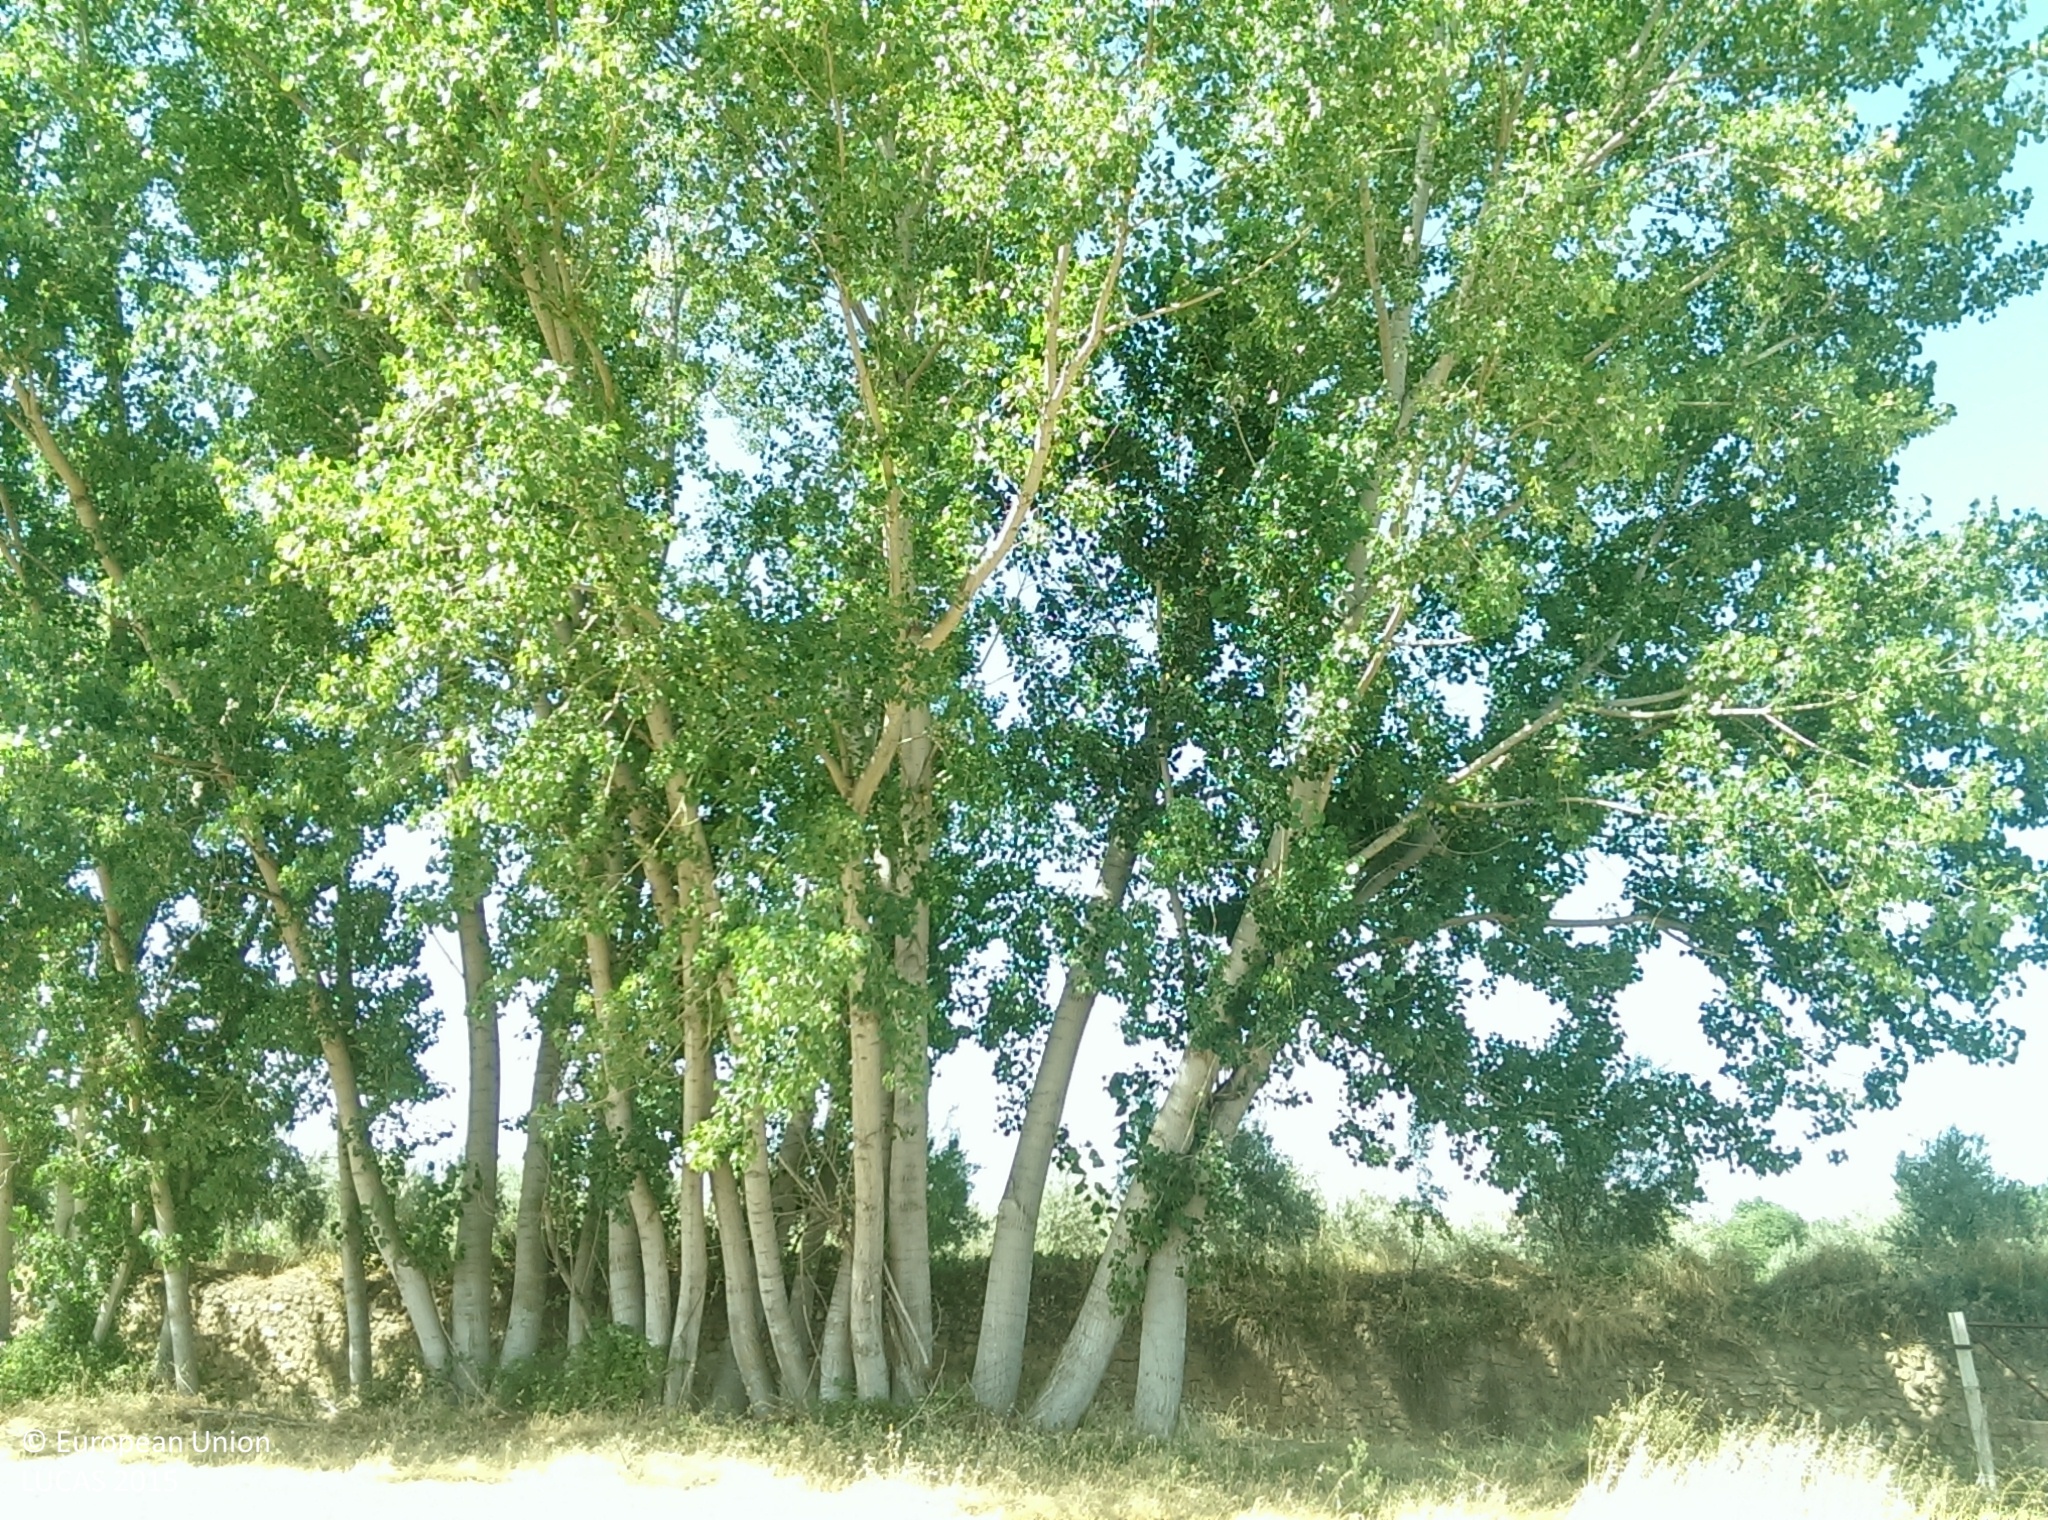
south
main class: Cropland
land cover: Nuts trees
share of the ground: 10 - 25 %
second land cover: Other bare soil
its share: > 75 %
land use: Agriculture (excluding fallow land and kitchen gardens)
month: July
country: ES
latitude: 37.3066
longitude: -3.1540
